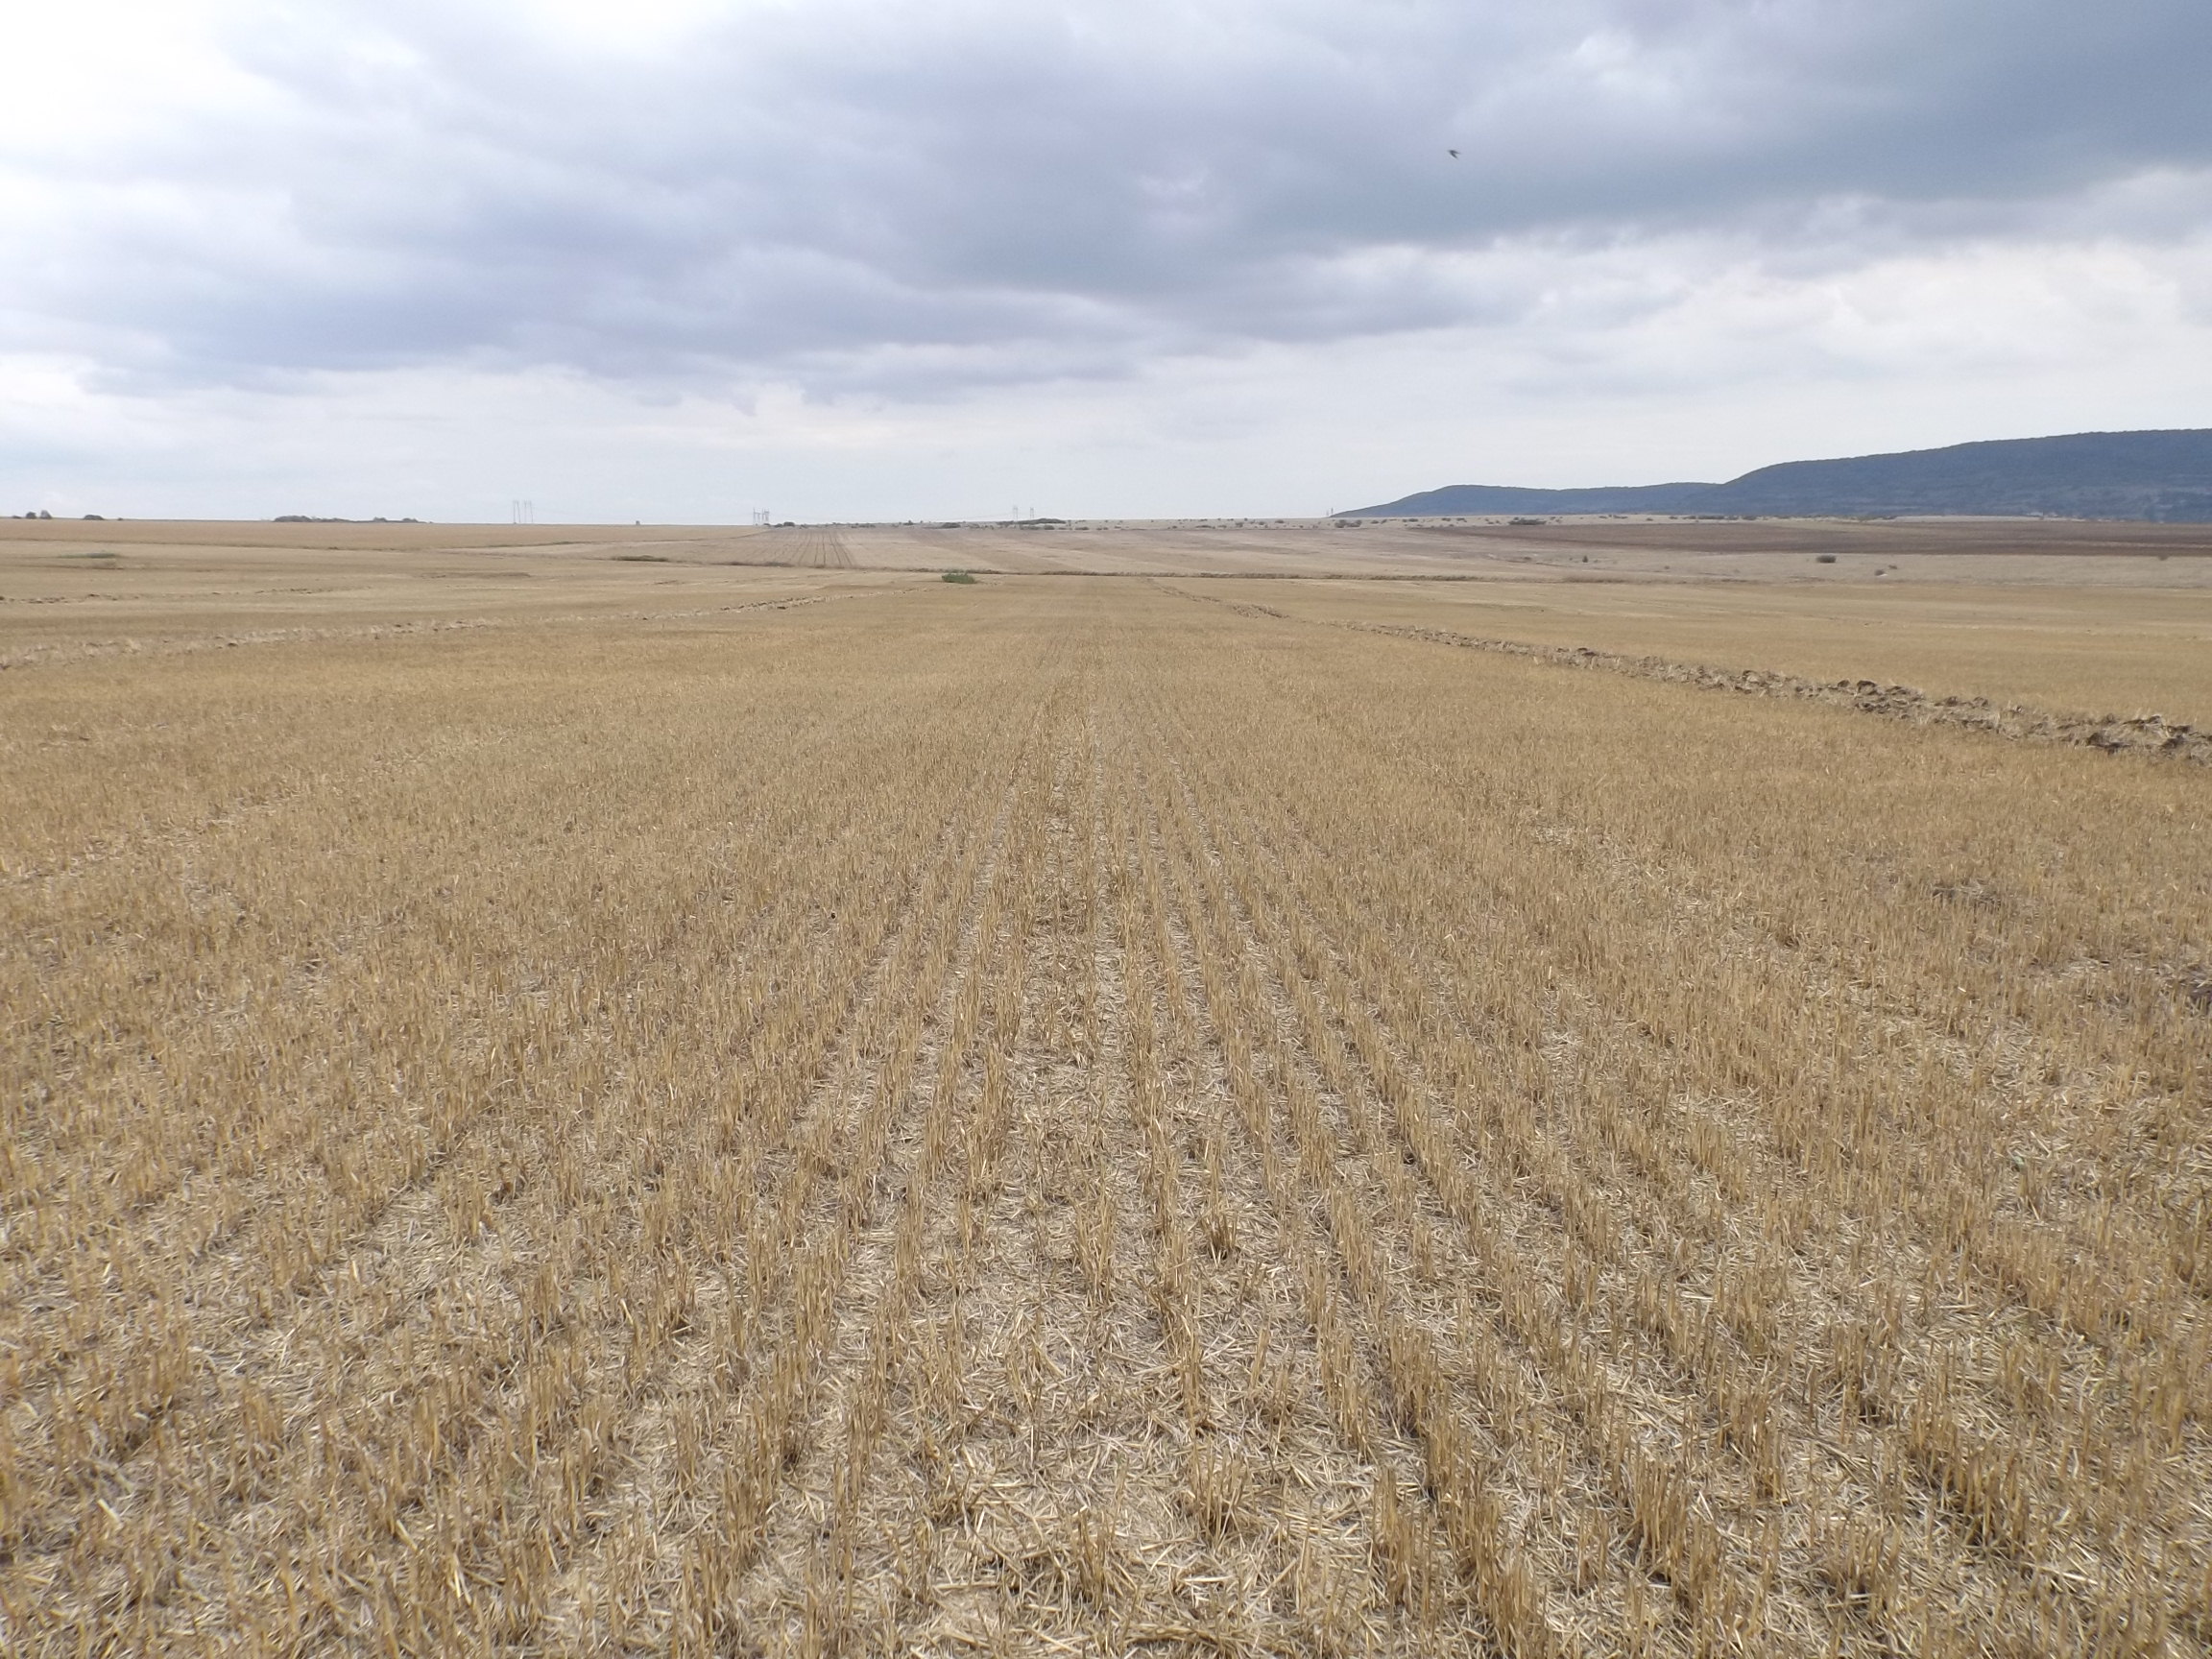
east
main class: Cropland
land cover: Common wheat
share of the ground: < 10 %
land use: Agriculture (excluding fallow land and kitchen gardens)
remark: Harvested field
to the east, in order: Common wheat; Spontaneously vegetated surfaces; Common wheat
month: August
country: BG
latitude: 43.2482
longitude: 27.4305
